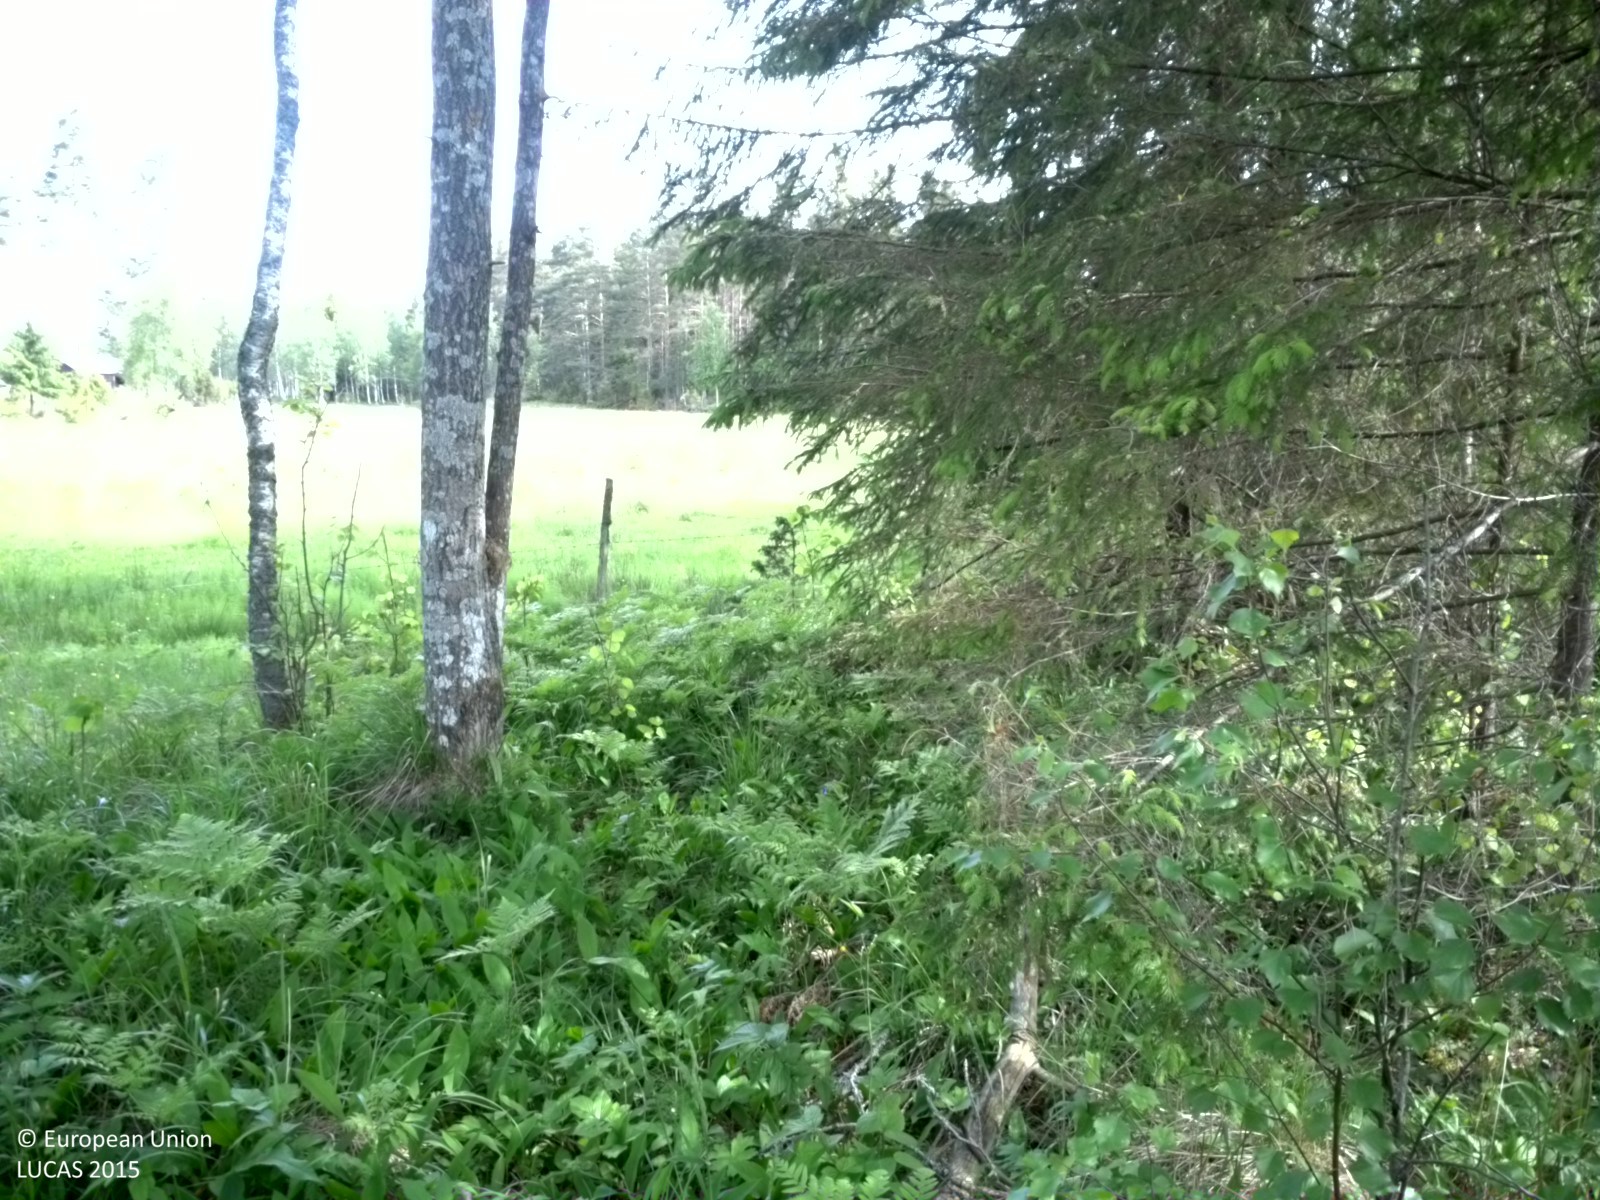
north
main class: Woodland
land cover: Spruce dominated mixed woodland
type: boreal forest
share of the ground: 50 - 75 %
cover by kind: herbaceous plants 35 %, coniferous forest trees 30 %, broadleaved forest trees 30 %, shrubs 5 %
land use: Forestry
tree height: > 5 m
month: June
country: SE
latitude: 60.3326
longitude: 18.0174
